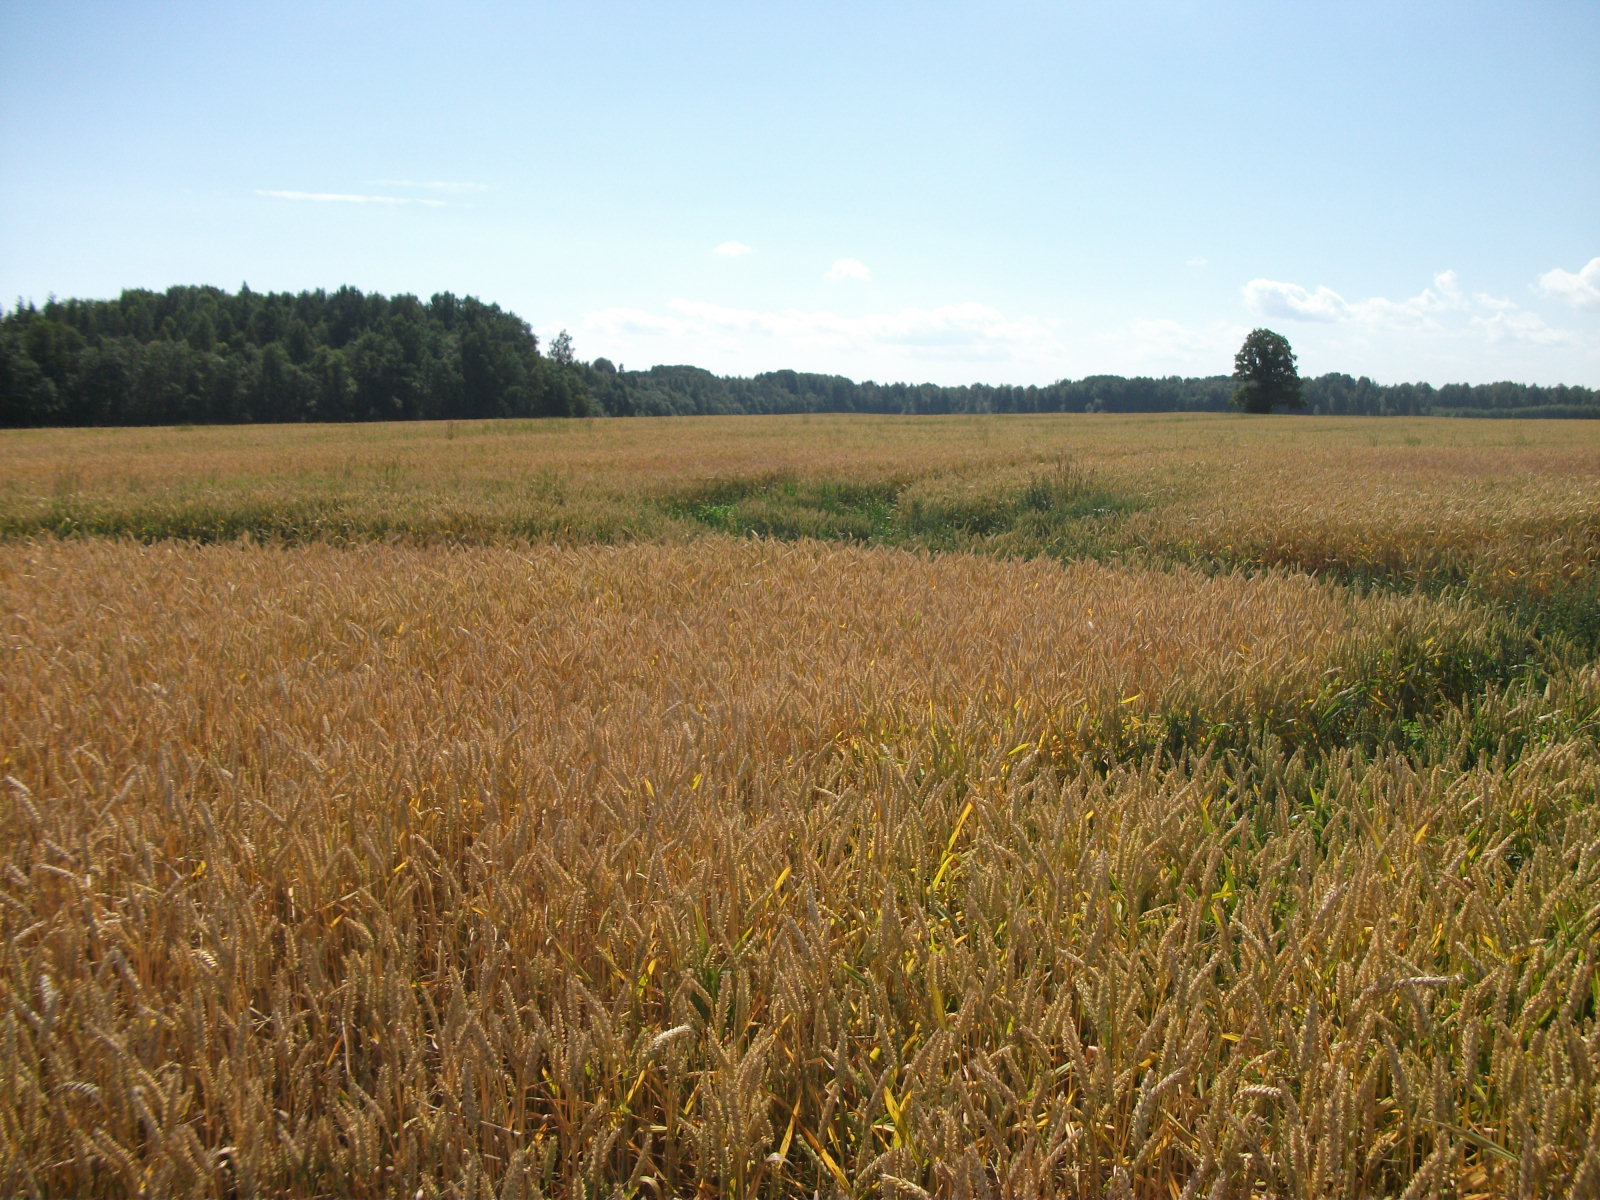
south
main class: Cropland
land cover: Common wheat
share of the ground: > 75 %
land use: Agriculture (excluding fallow land and kitchen gardens)
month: August
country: LV
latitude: 57.0714
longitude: 26.6946
